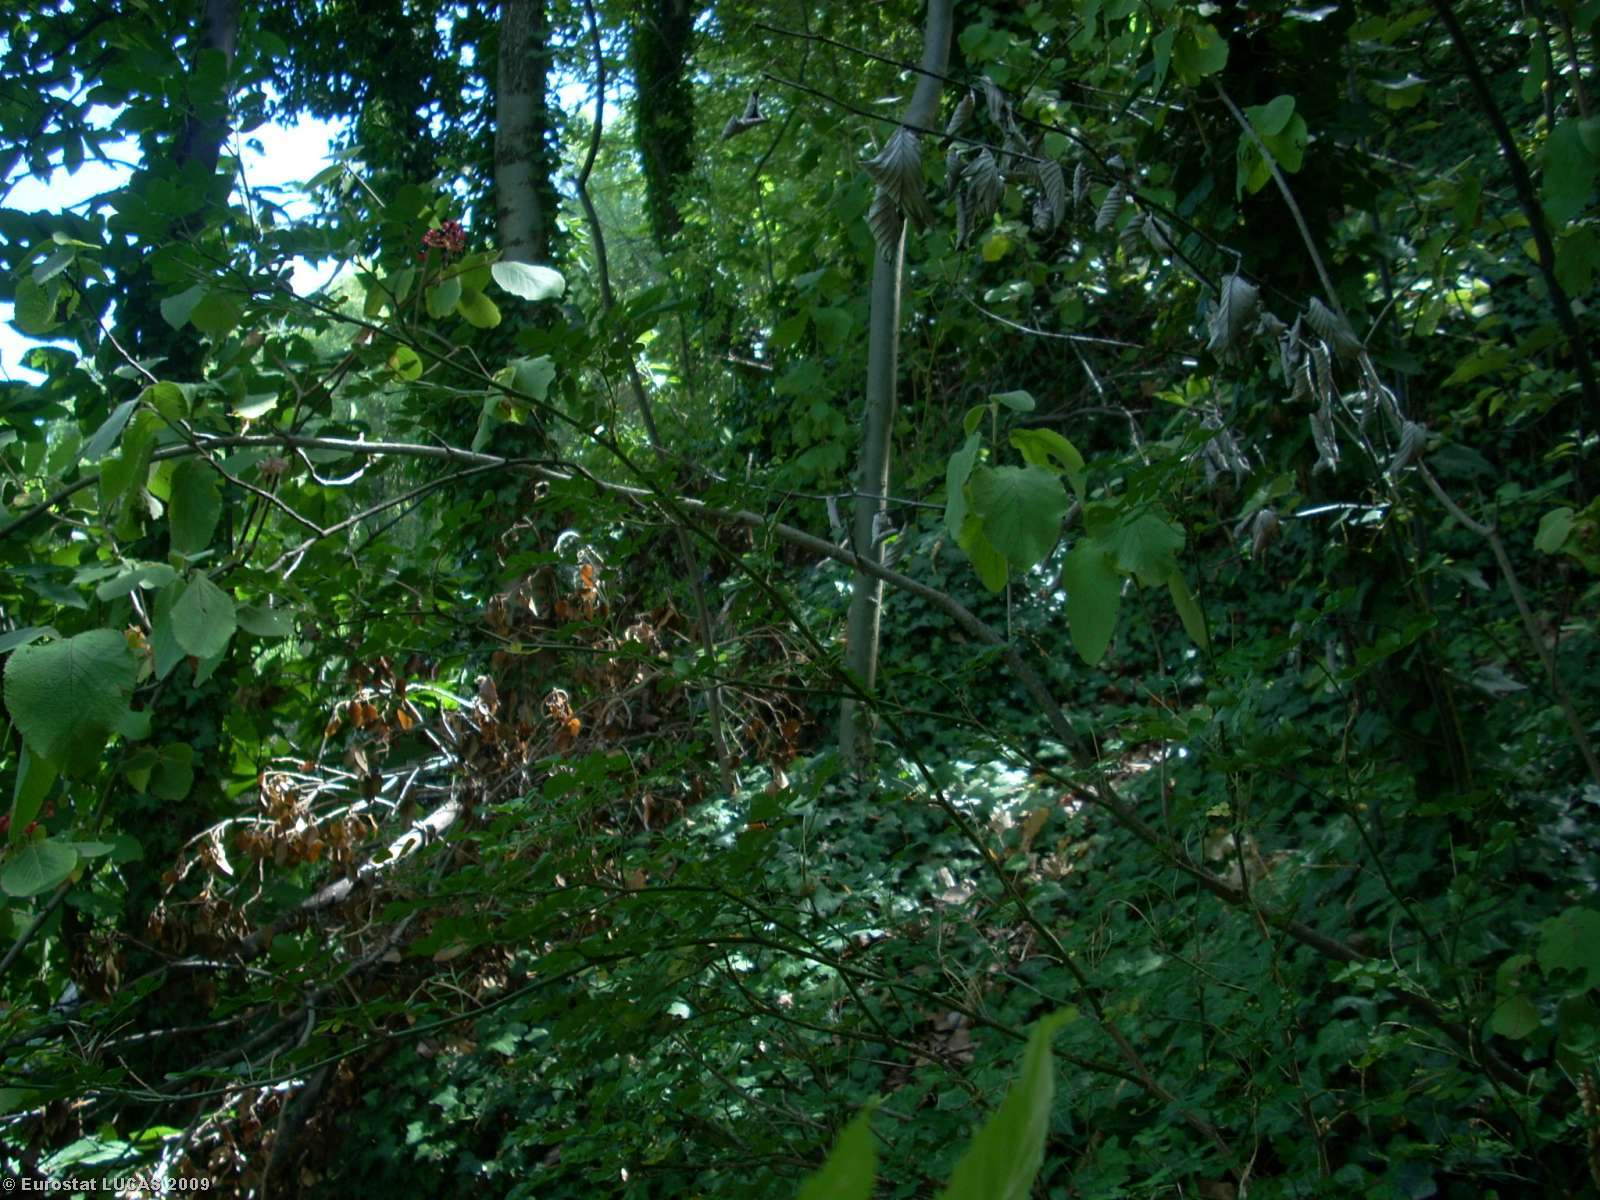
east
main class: Woodland
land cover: Mixed woodland
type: mesophytic deciduous forest
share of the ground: > 75 %
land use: Forestry
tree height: > 5 m
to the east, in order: Mixed woodland; Grassland without tree/shrub cover; Mixed woodland; Grass margins; Paved roads, cycling and walking lanes; Groves; Mixed woodland
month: July
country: IT
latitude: 45.7234
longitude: 7.3440
